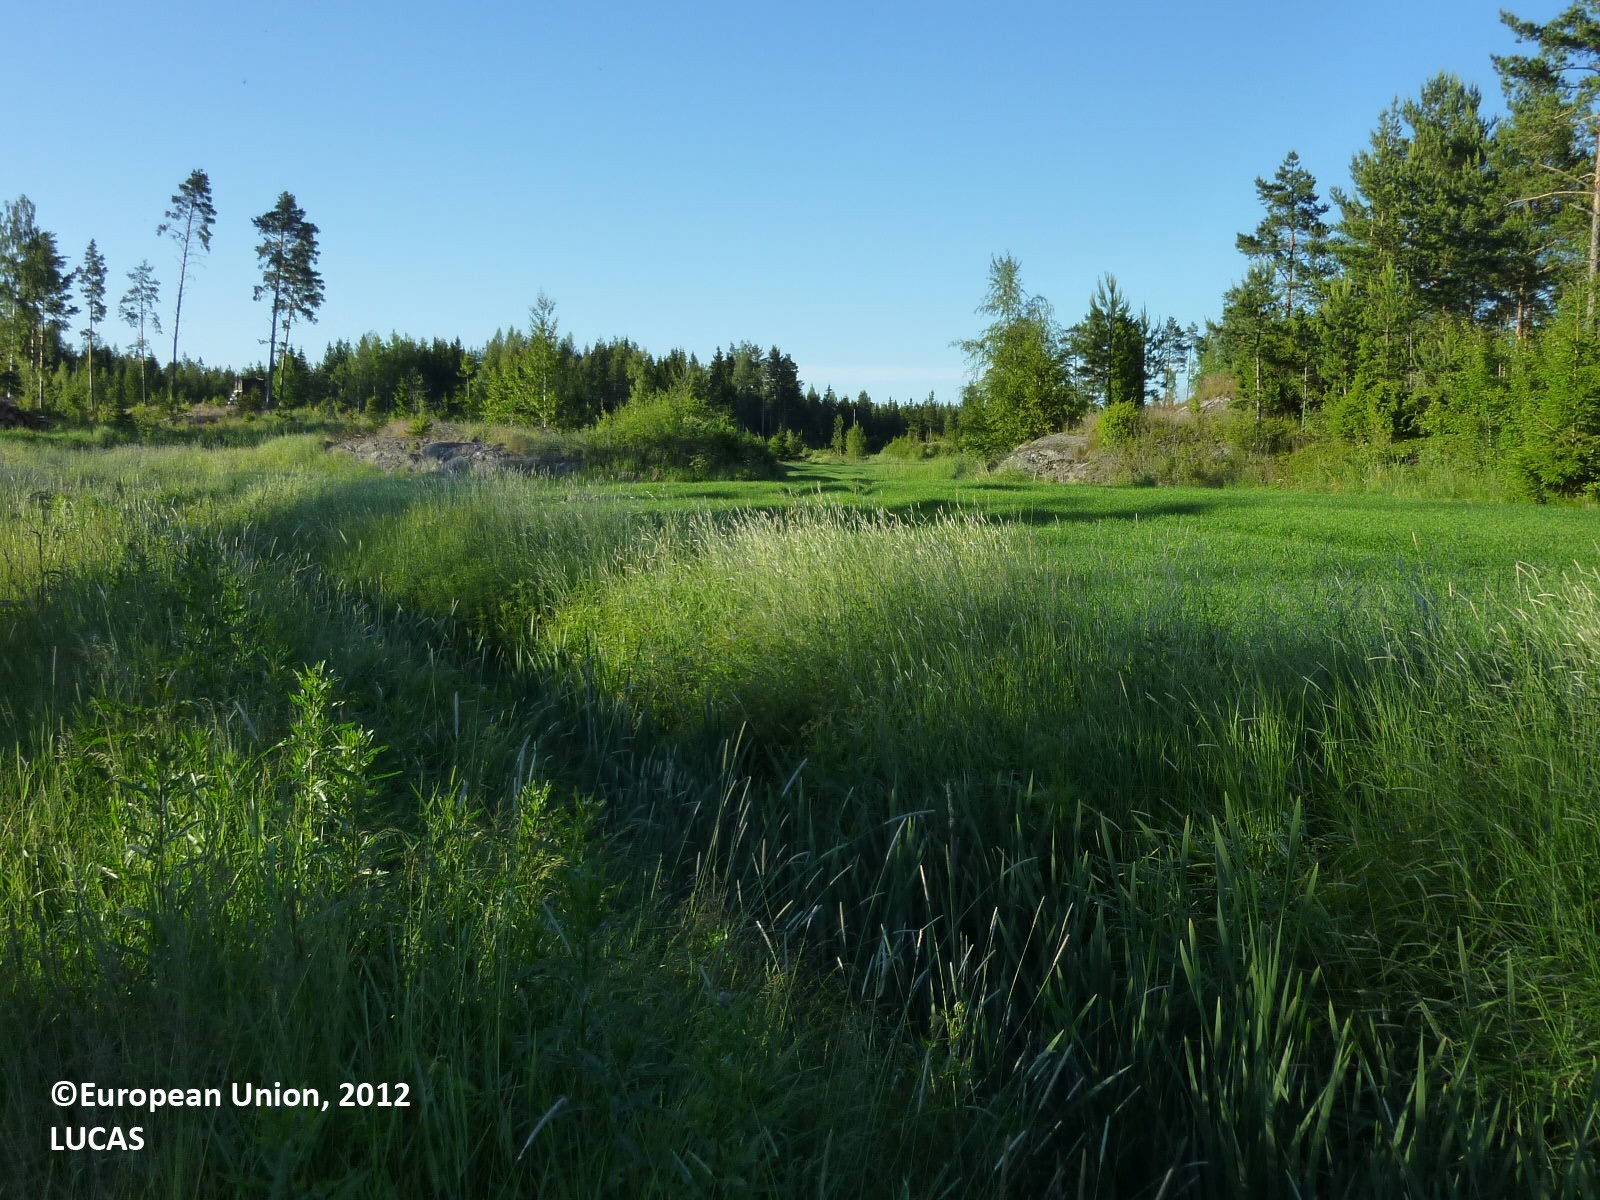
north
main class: Cropland
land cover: Oats
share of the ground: > 75 %
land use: Agriculture (excluding fallow land and kitchen gardens)
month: June
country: FI
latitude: 60.0854
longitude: 22.4215
